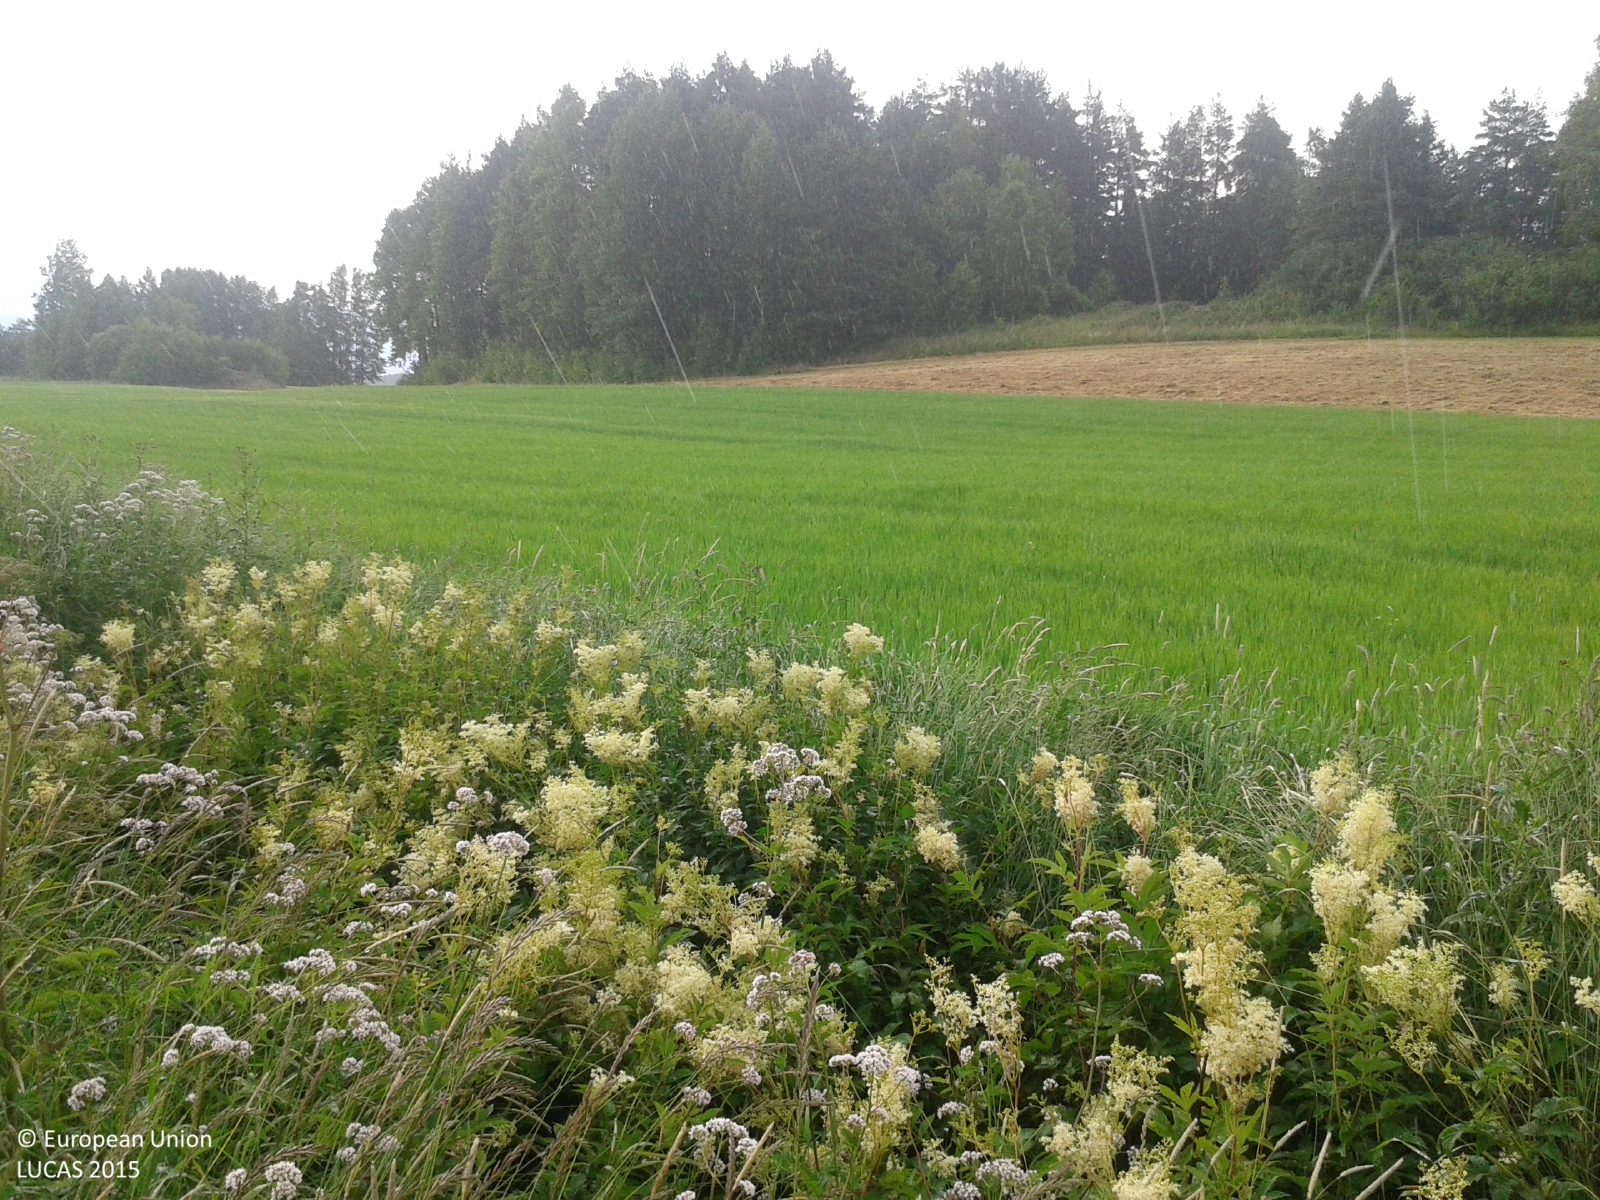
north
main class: Cropland
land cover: Barley
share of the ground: > 75 %
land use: Agriculture (excluding fallow land and kitchen gardens)
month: July
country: FI
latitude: 60.0865
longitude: 23.9585
